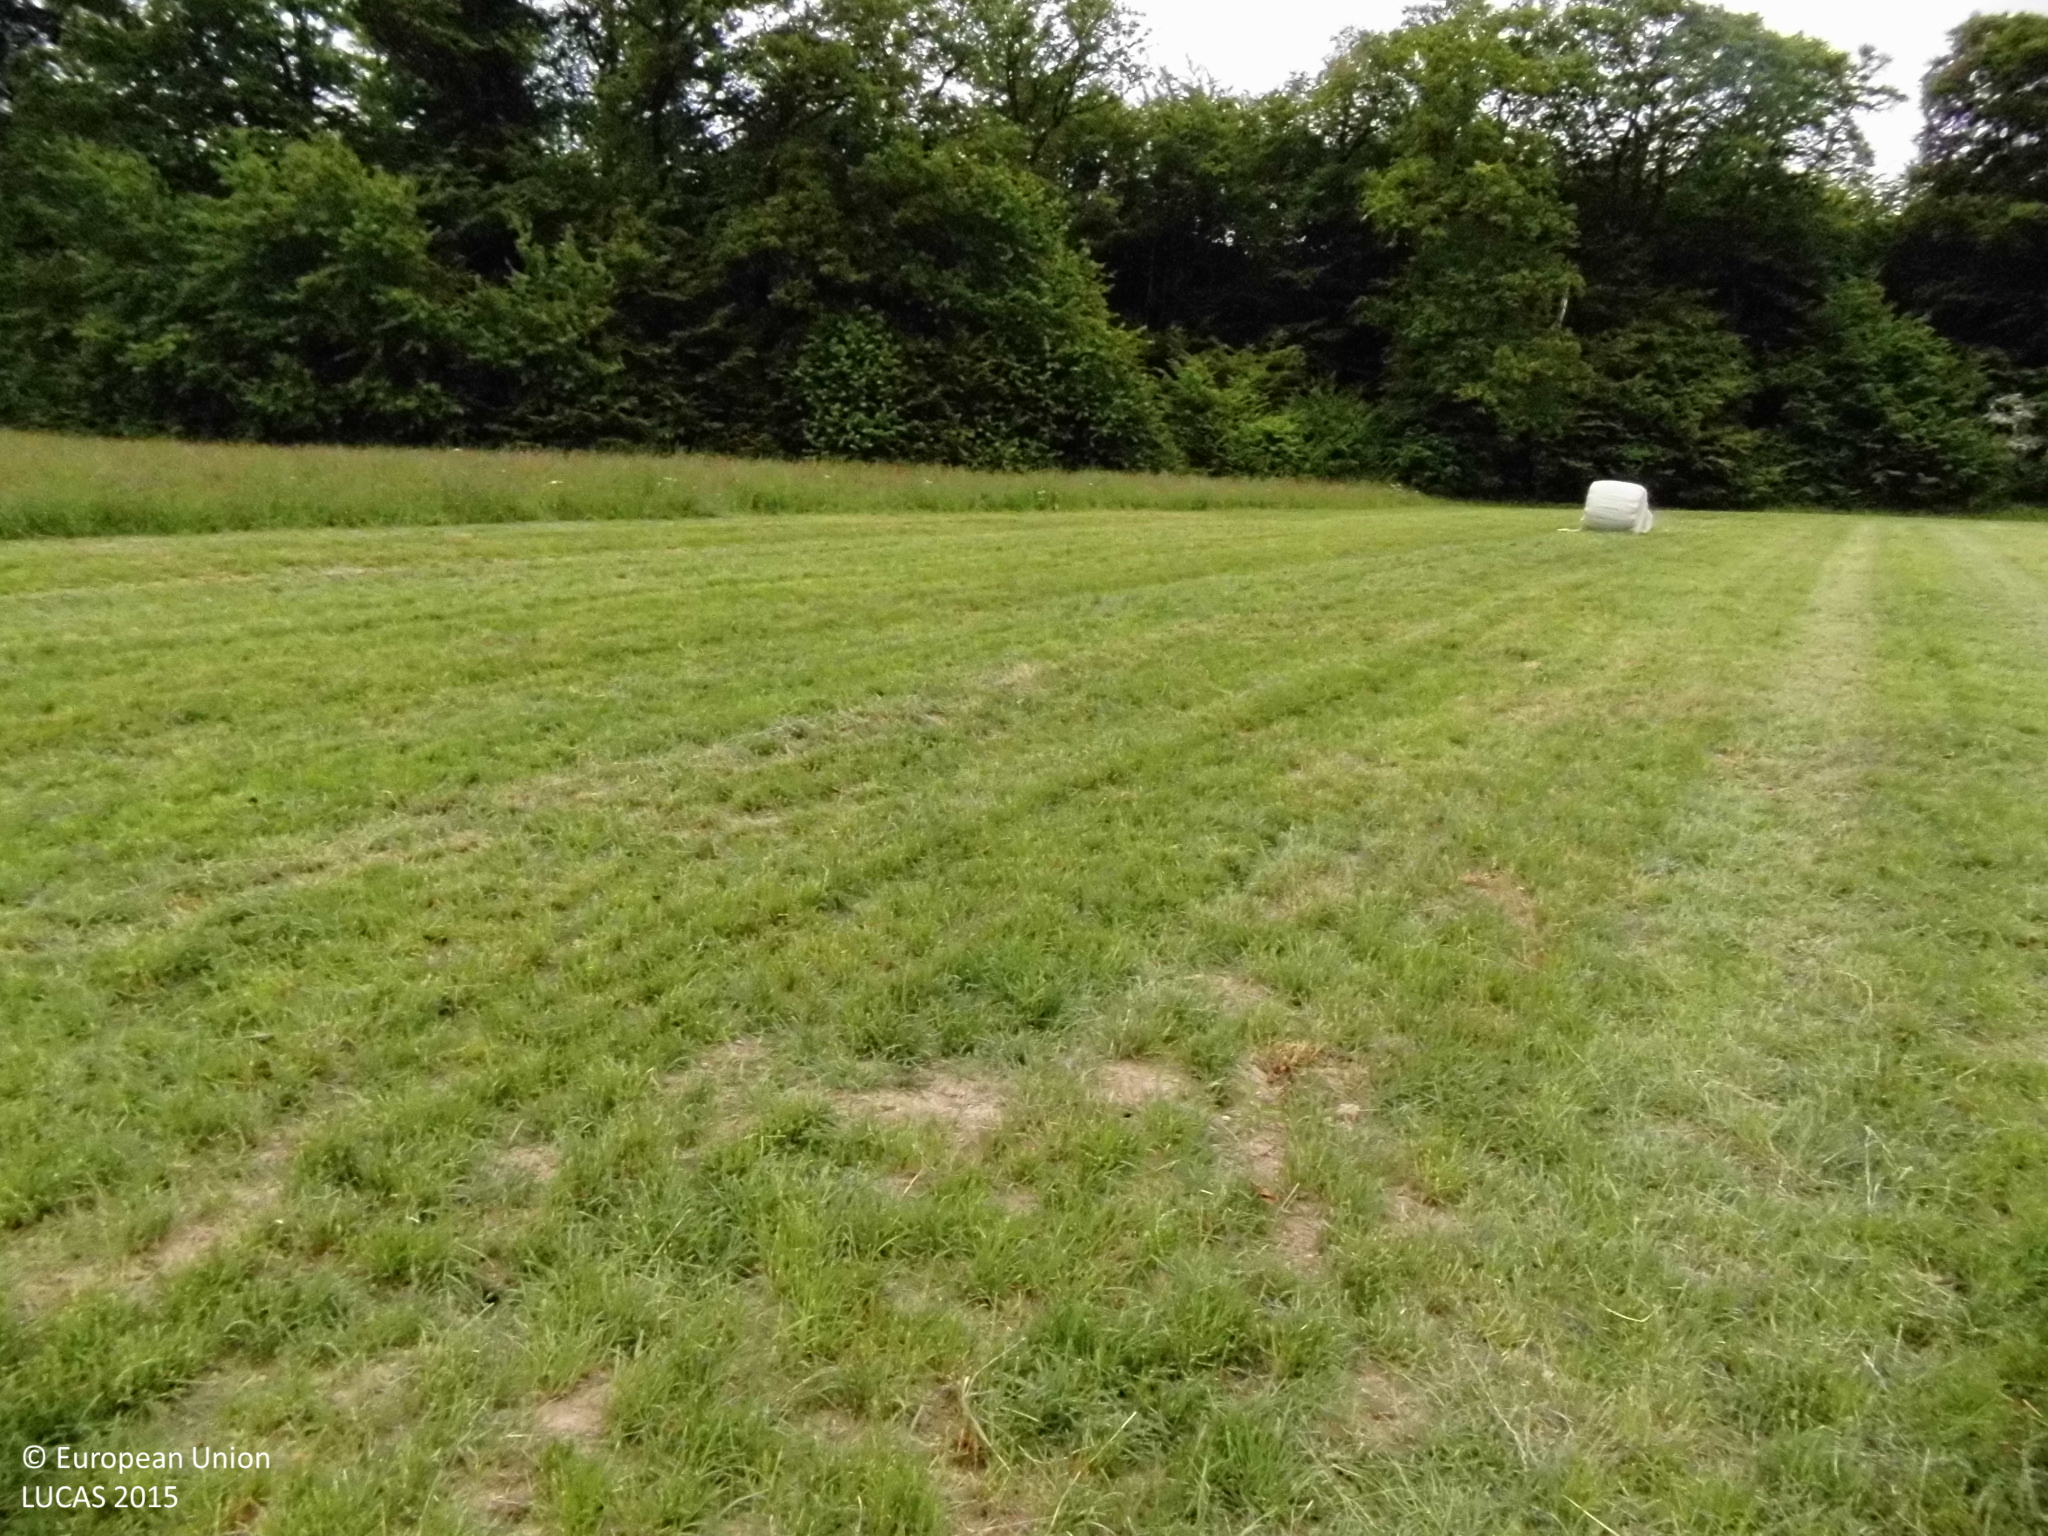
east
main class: Grassland
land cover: Grassland without tree/shrub cover
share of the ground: > 75 %
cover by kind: herbaceous plants 100 %
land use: Agriculture (excluding fallow land and kitchen gardens)
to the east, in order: Grassland without tree/shrub cover; Tracks; Grass margins; Broadleaved woodland; Tracks; Broadleaved woodland; Tracks; Broadleaved woodland
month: May
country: DE
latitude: 50.5341
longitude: 7.4748
